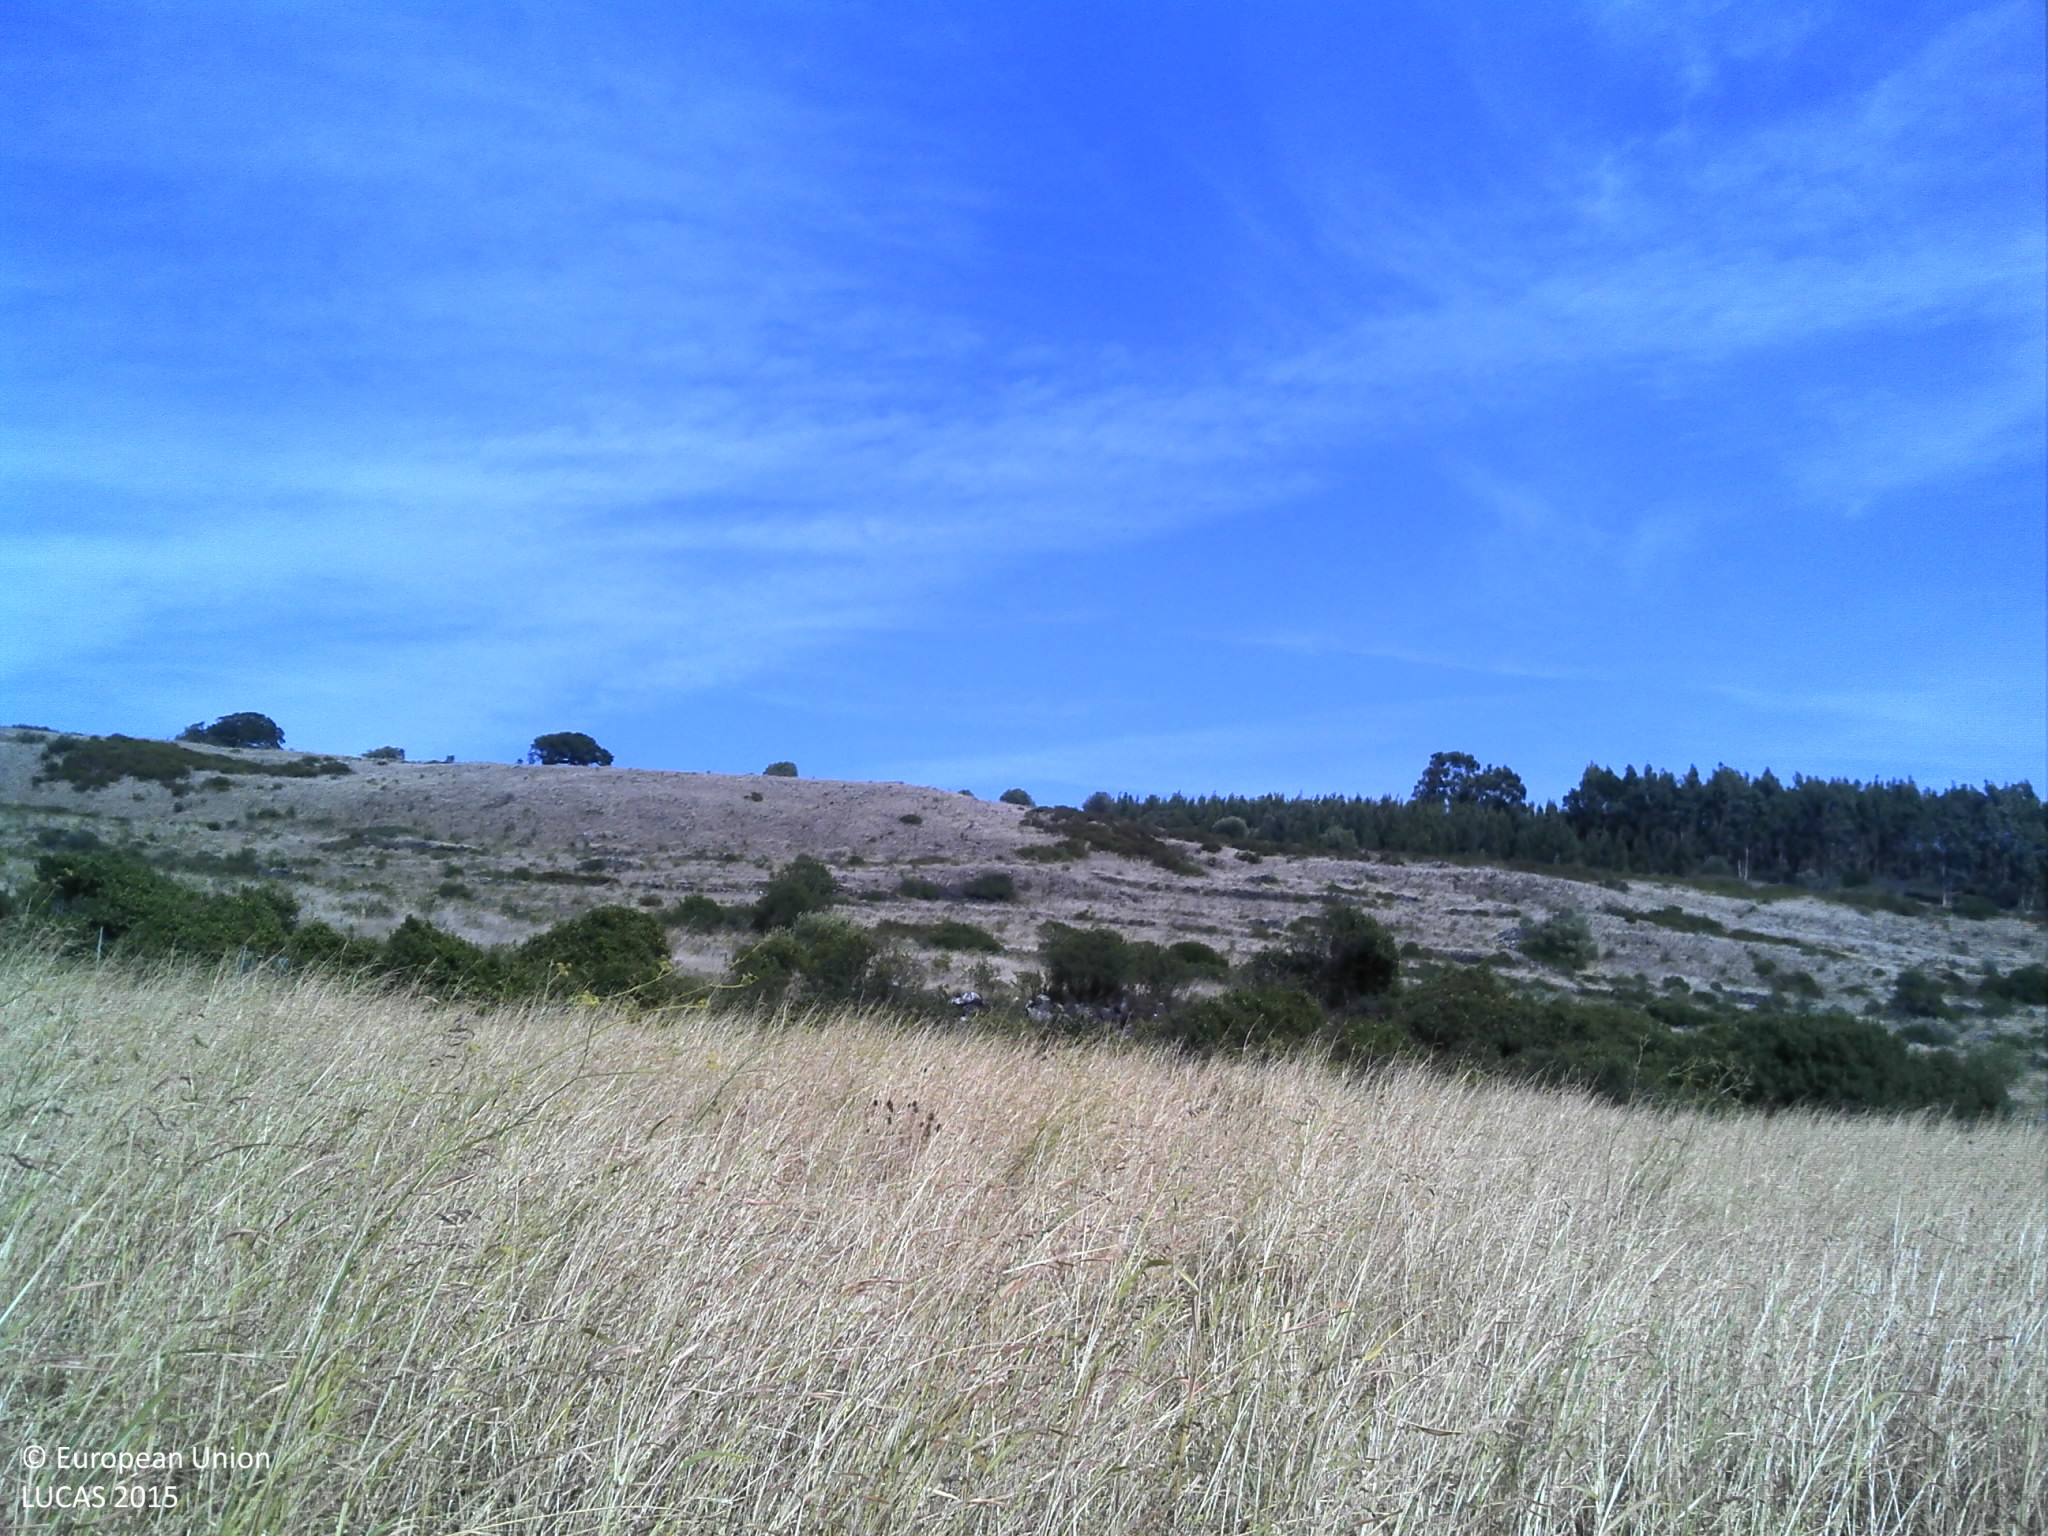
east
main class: Cropland
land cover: Other cereals
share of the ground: 50 - 75 %
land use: Agriculture (excluding fallow land and kitchen gardens)
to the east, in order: Other cereals; Fences; Shruby margins; Dry stone walls; Grassland with sparse tree/shrub cover; Dry stone walls; Grassland without tree/shrub cover; Rock outcrops; Grassland without tree/shrub cover
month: September
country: PT
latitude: 38.8696
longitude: -9.2009
